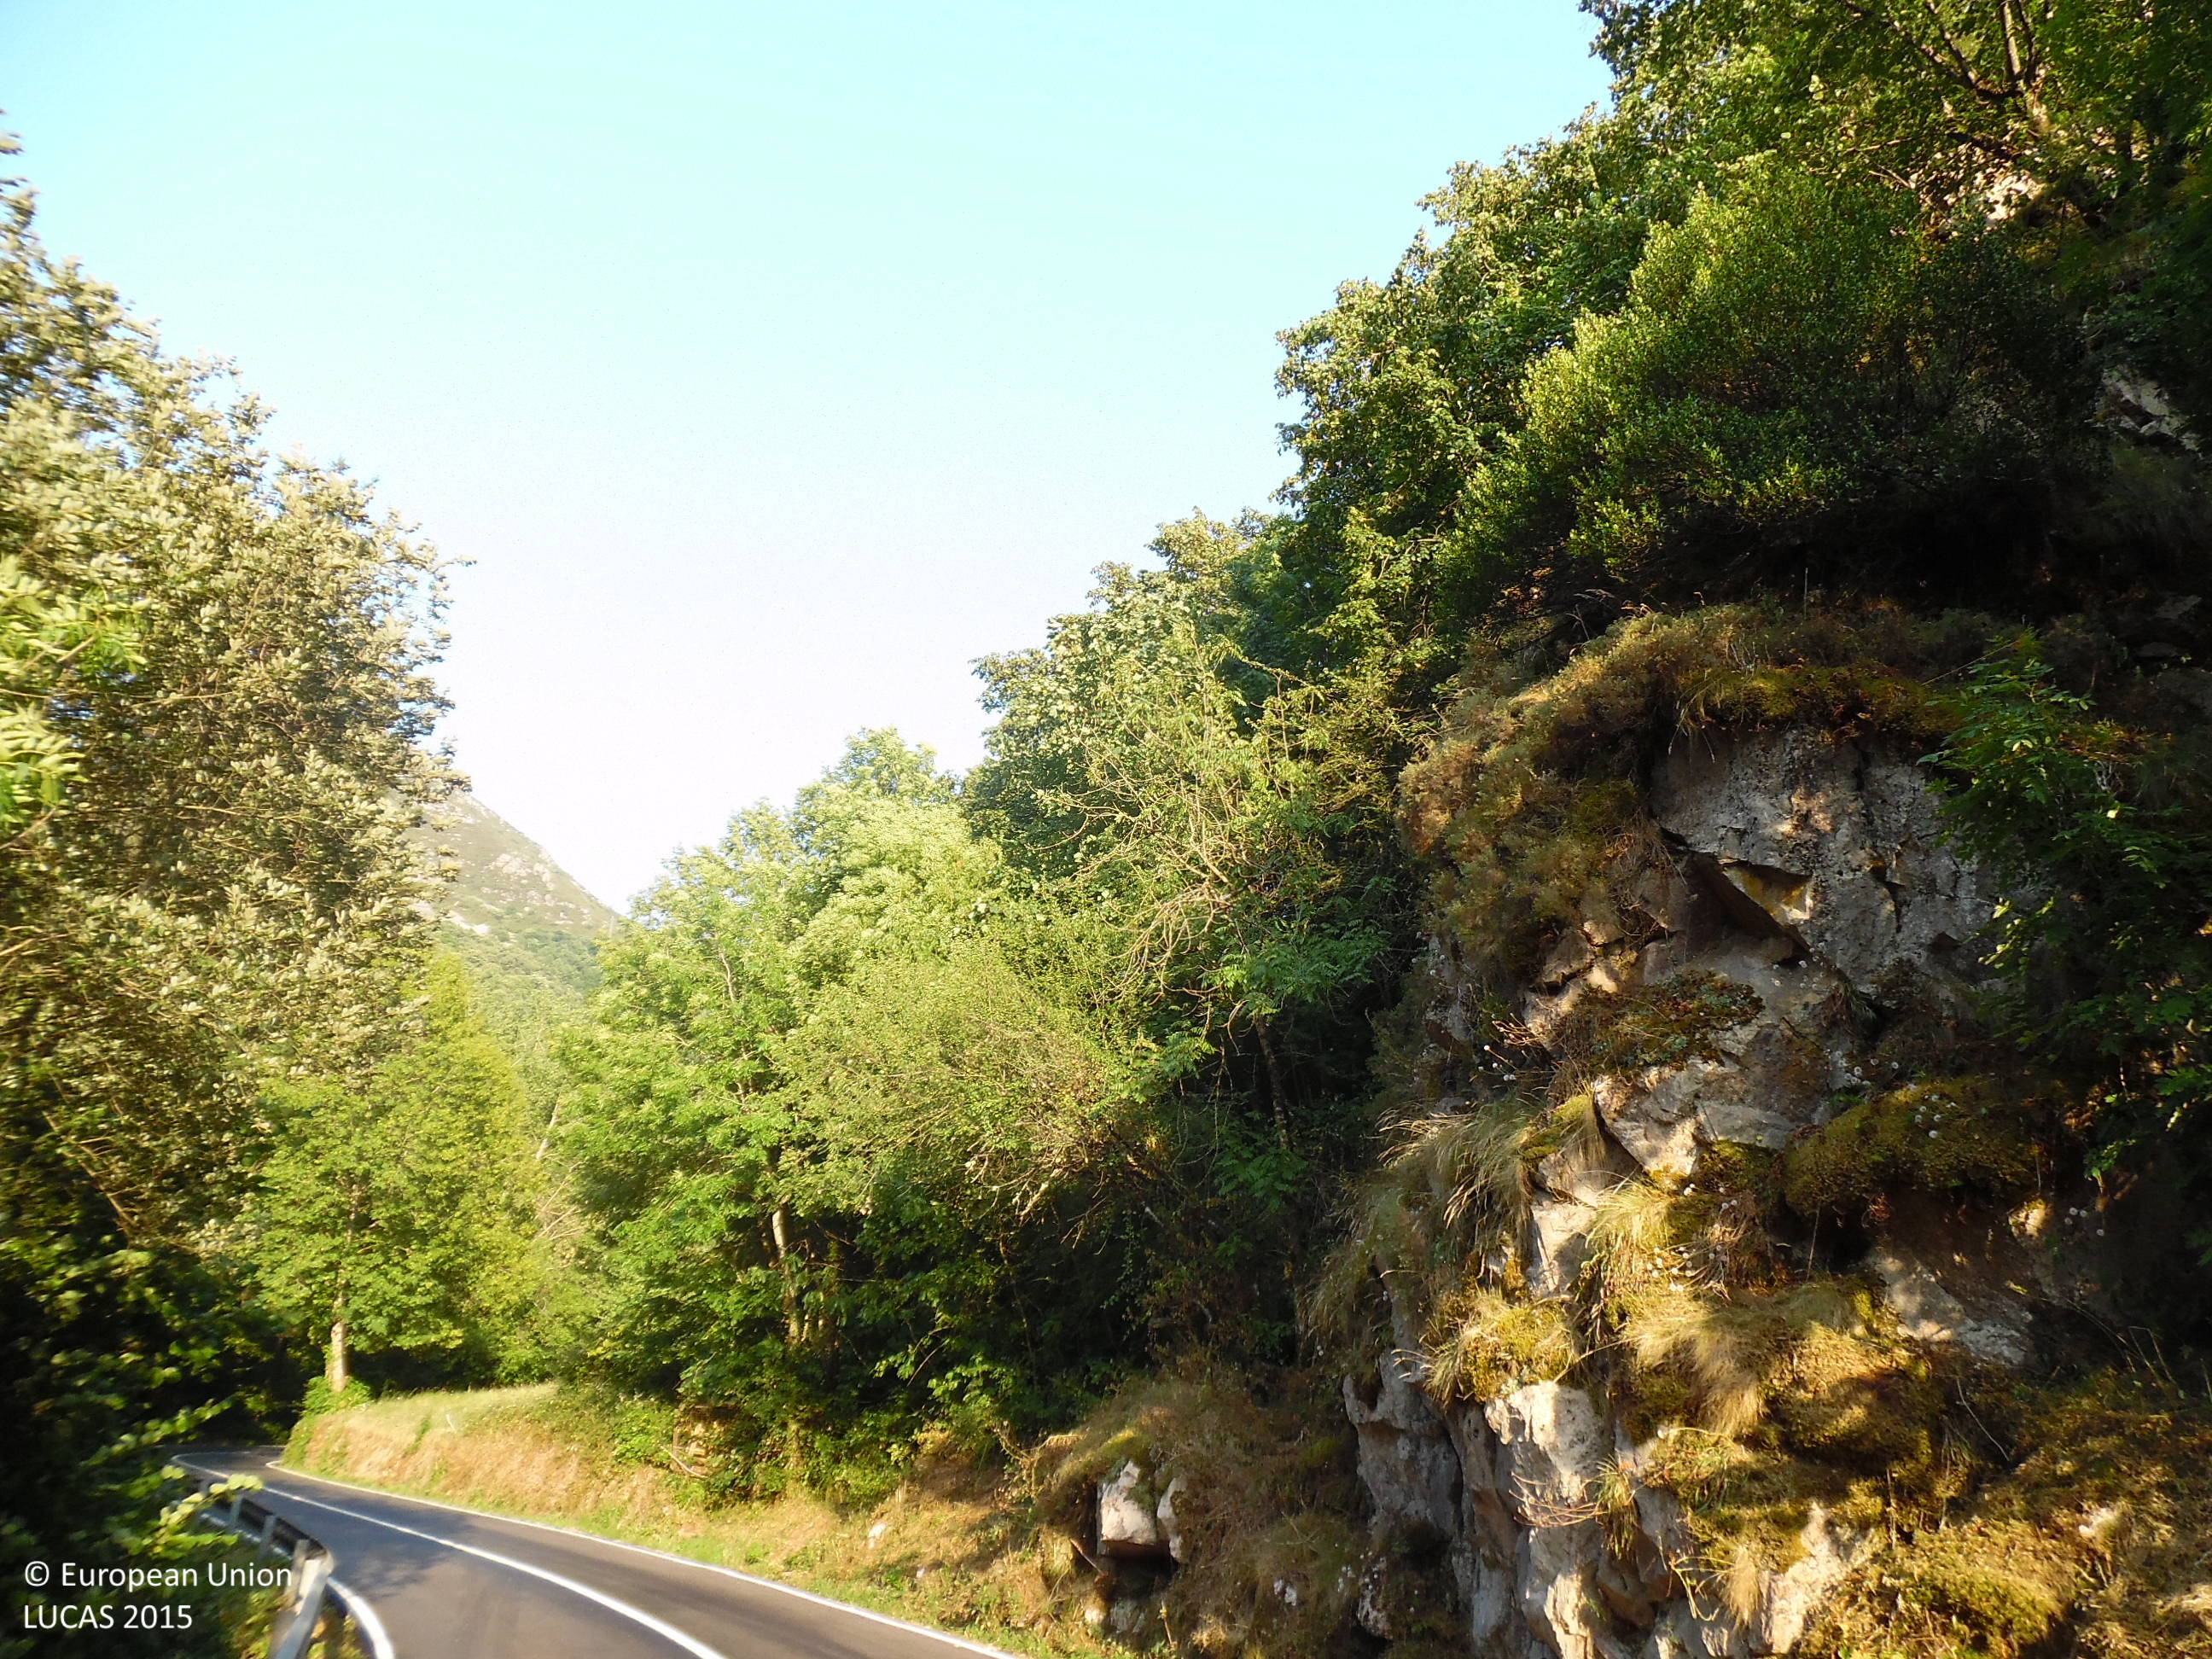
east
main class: Woodland
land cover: Broadleaved woodland
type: thermophilous deciduous forest
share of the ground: > 75 %
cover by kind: broadleaved forest trees 95 %, shrubs 5 %
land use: Forestry
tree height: > 5 m
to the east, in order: Broadleaved woodland; Rocks and stones; Broadleaved woodland; Electric lines; Broadleaved woodland; Grassland with sparse tree/shrub cover; Abandoned hedges
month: July
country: ES
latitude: 43.1664
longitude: -6.2696
